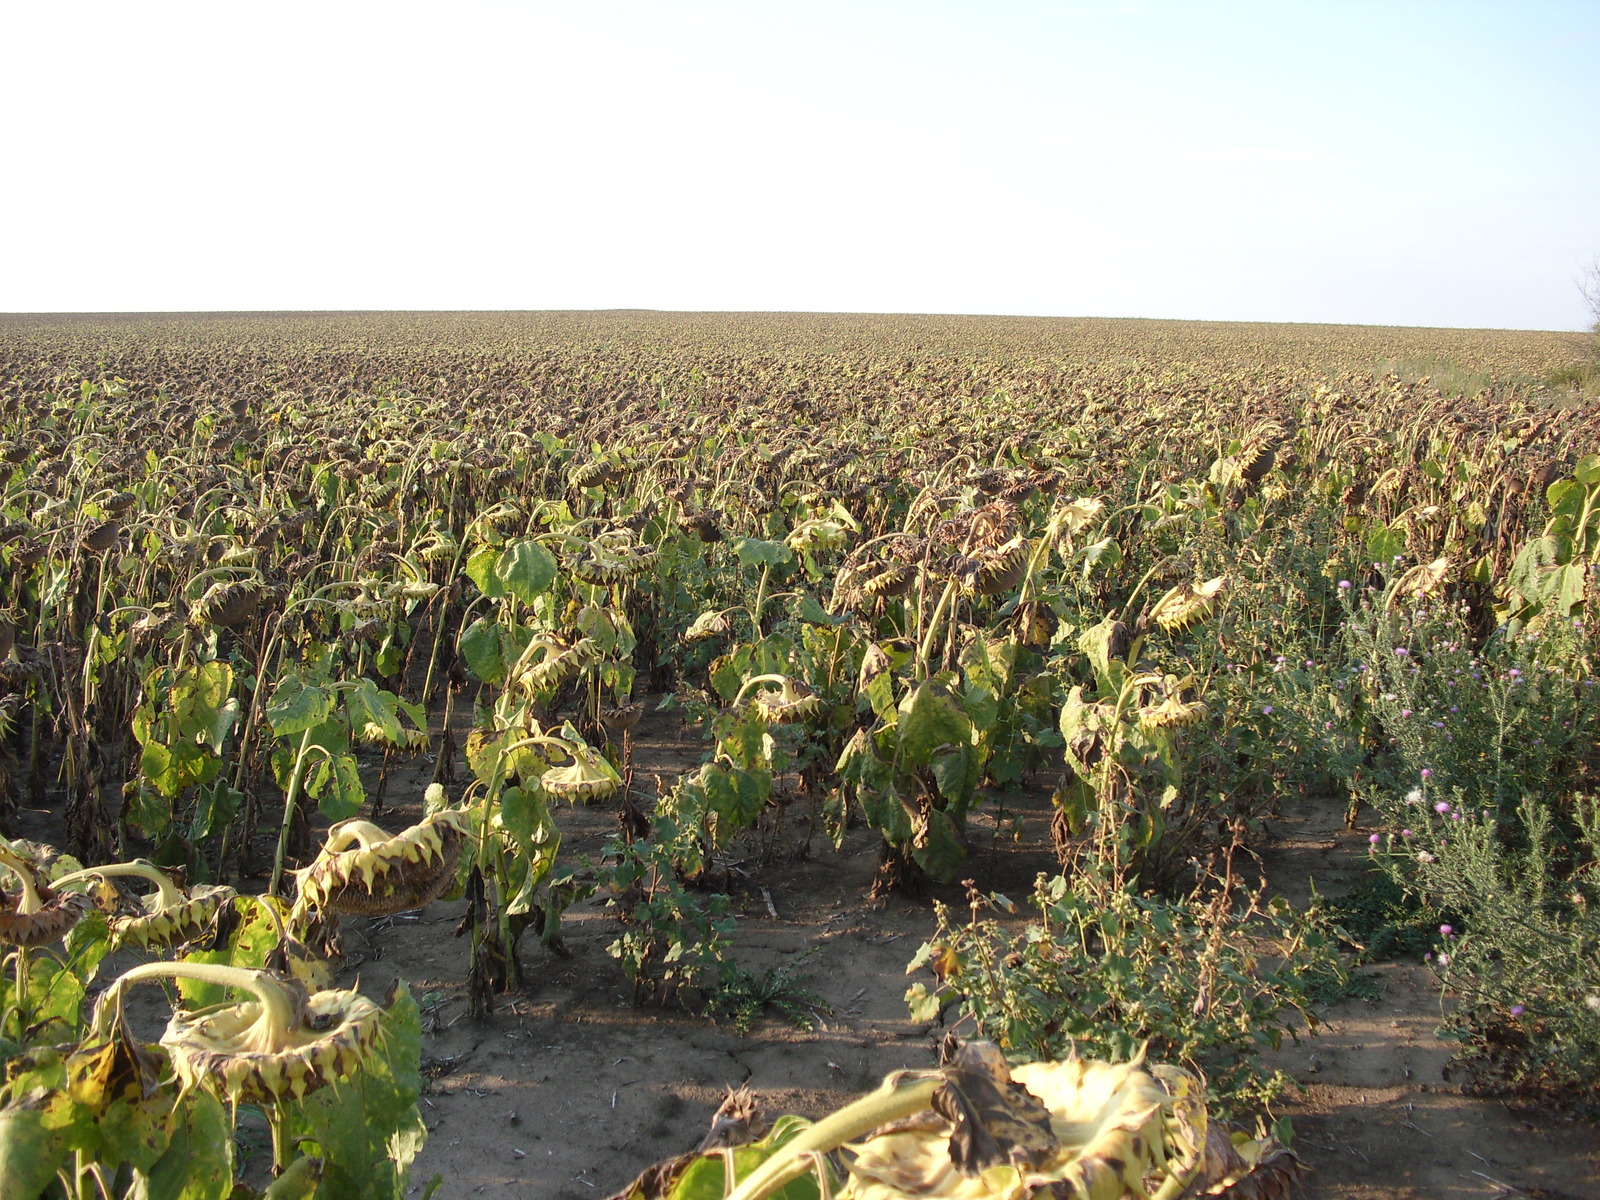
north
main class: Cropland
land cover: Sunflower
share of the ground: > 75 %
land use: Agriculture (excluding fallow land and kitchen gardens)
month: August
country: BG
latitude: 43.7193
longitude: 23.3631
